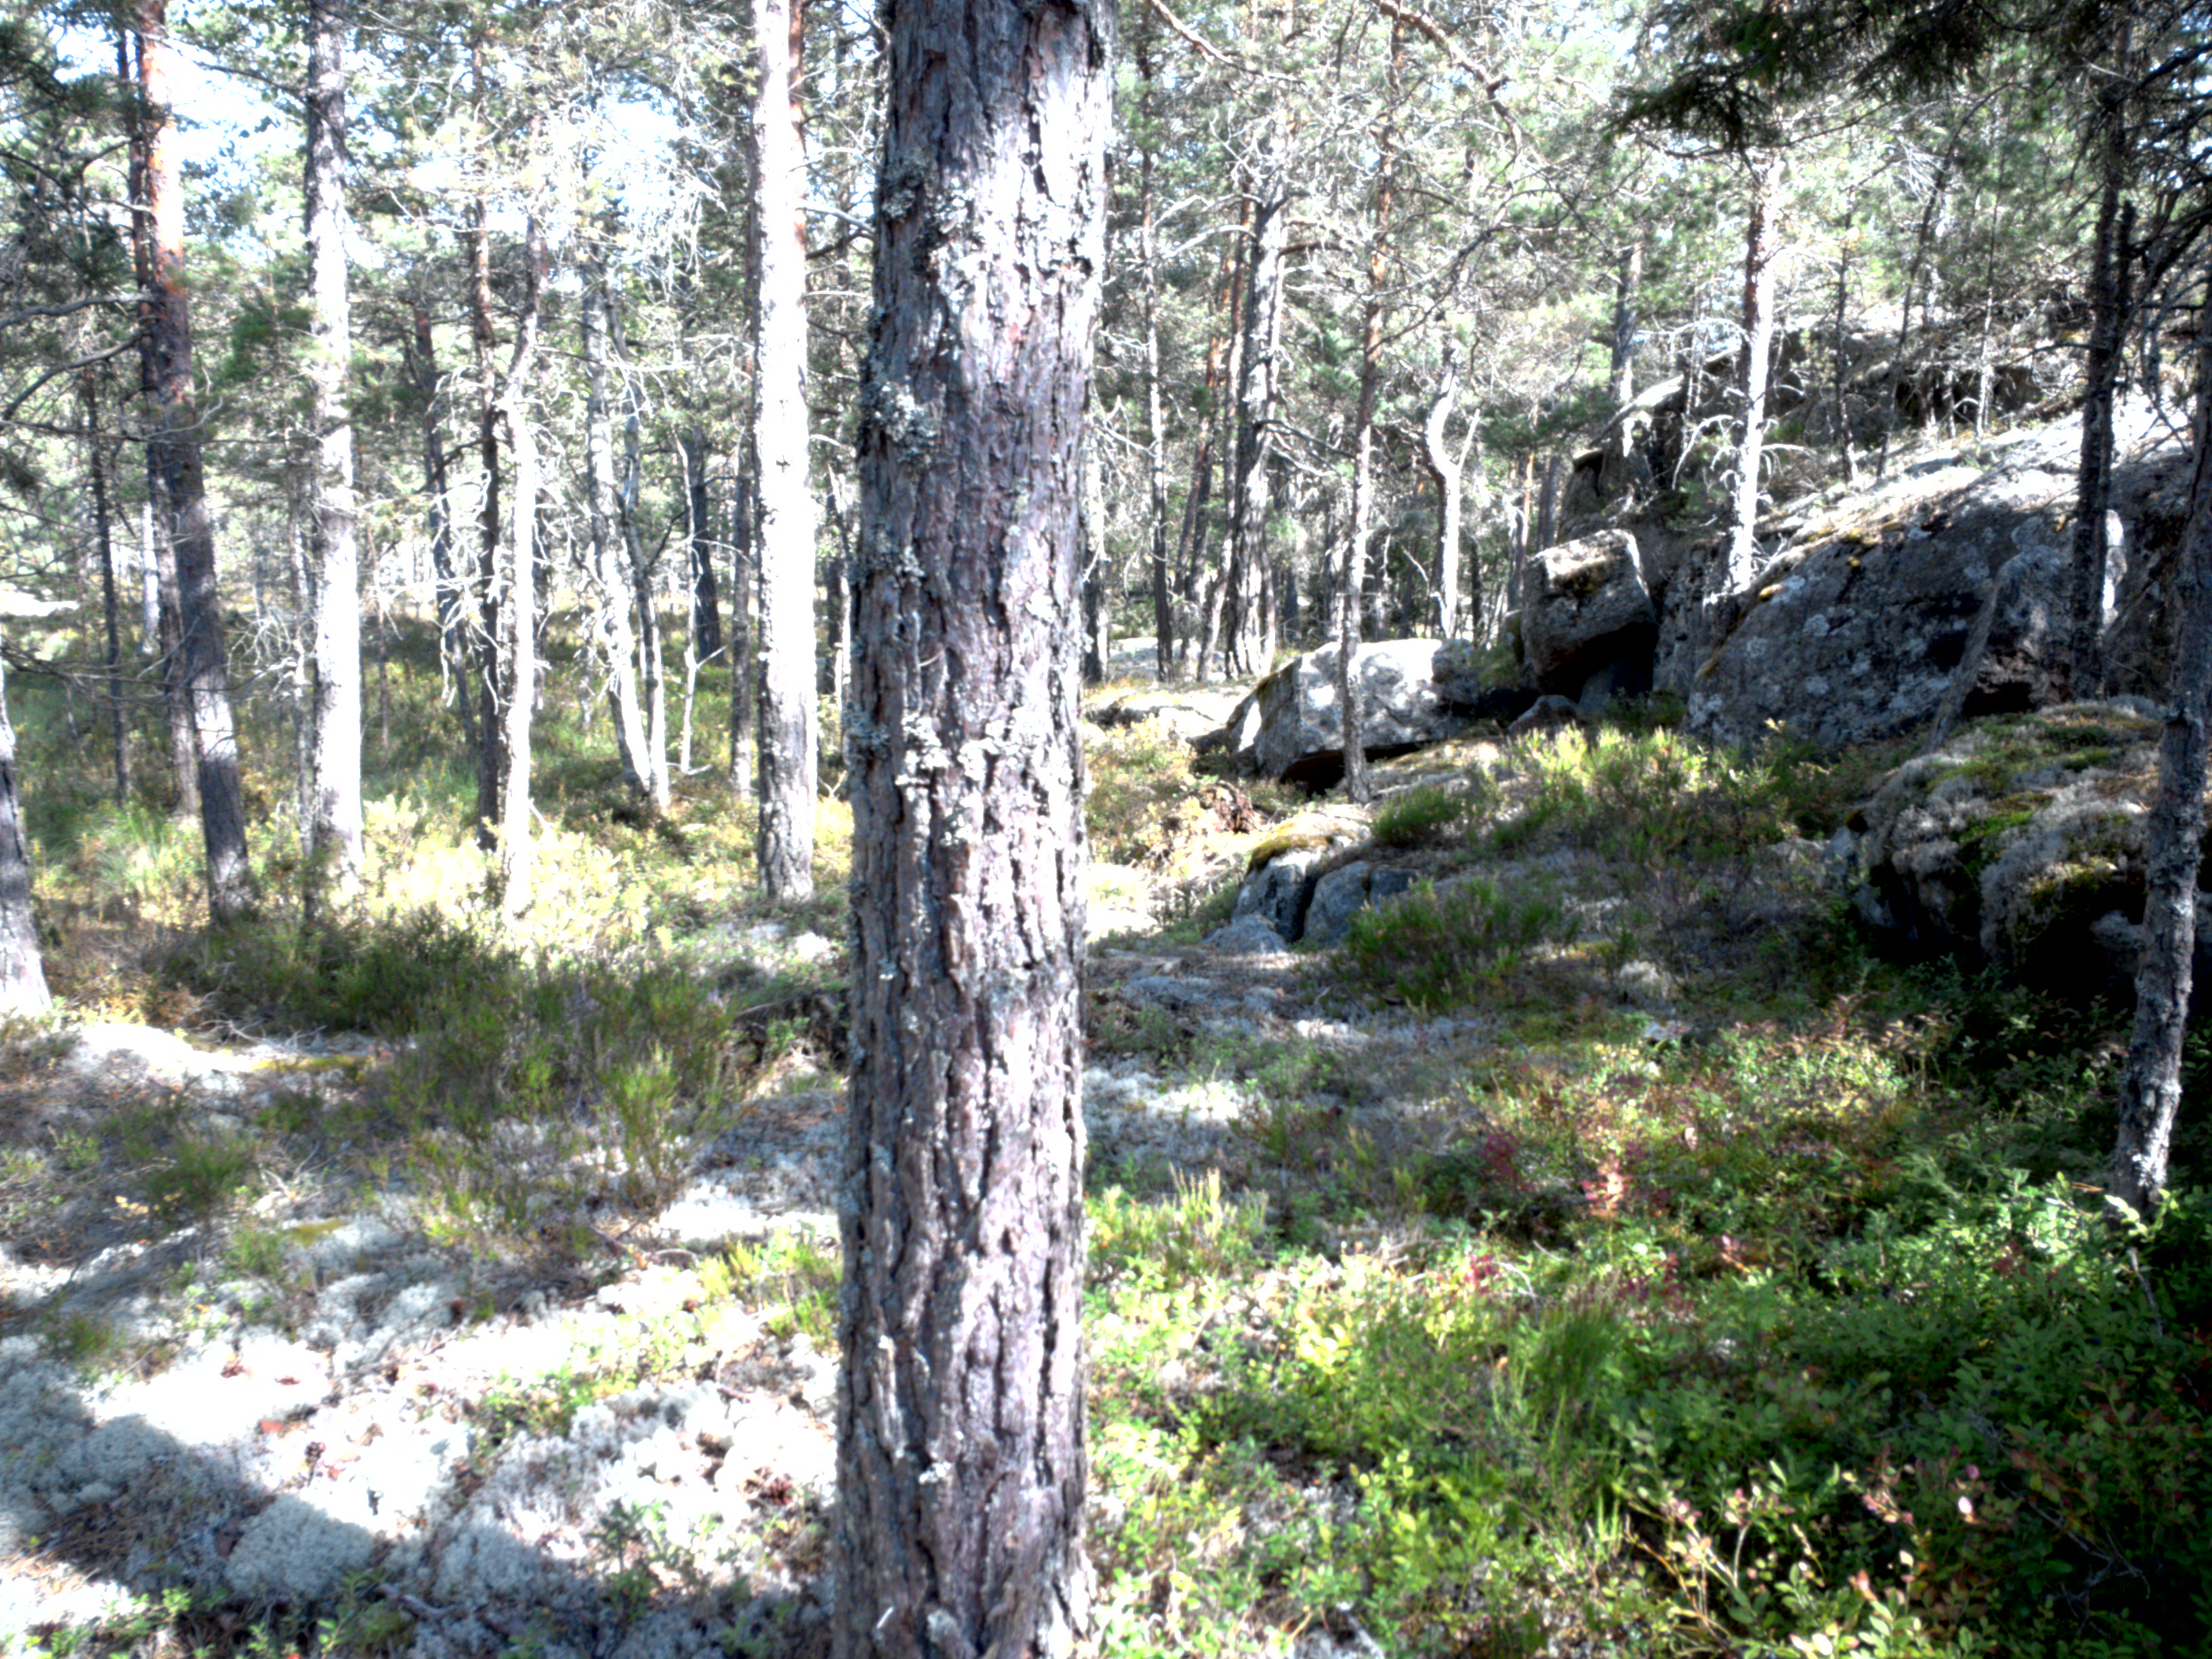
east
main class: Woodland
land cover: Pine dominated coniferous woodland
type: boreal forest
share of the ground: 25 - 50 %
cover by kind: coniferous forest trees 50 %, shrubs 25 %, lichens and mosses 25 %
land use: Forestry
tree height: > 5 m
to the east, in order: Pine dominated coniferous woodland; Pine dominated mixed woodland
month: August
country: SE
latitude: 59.0955
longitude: 17.4856
